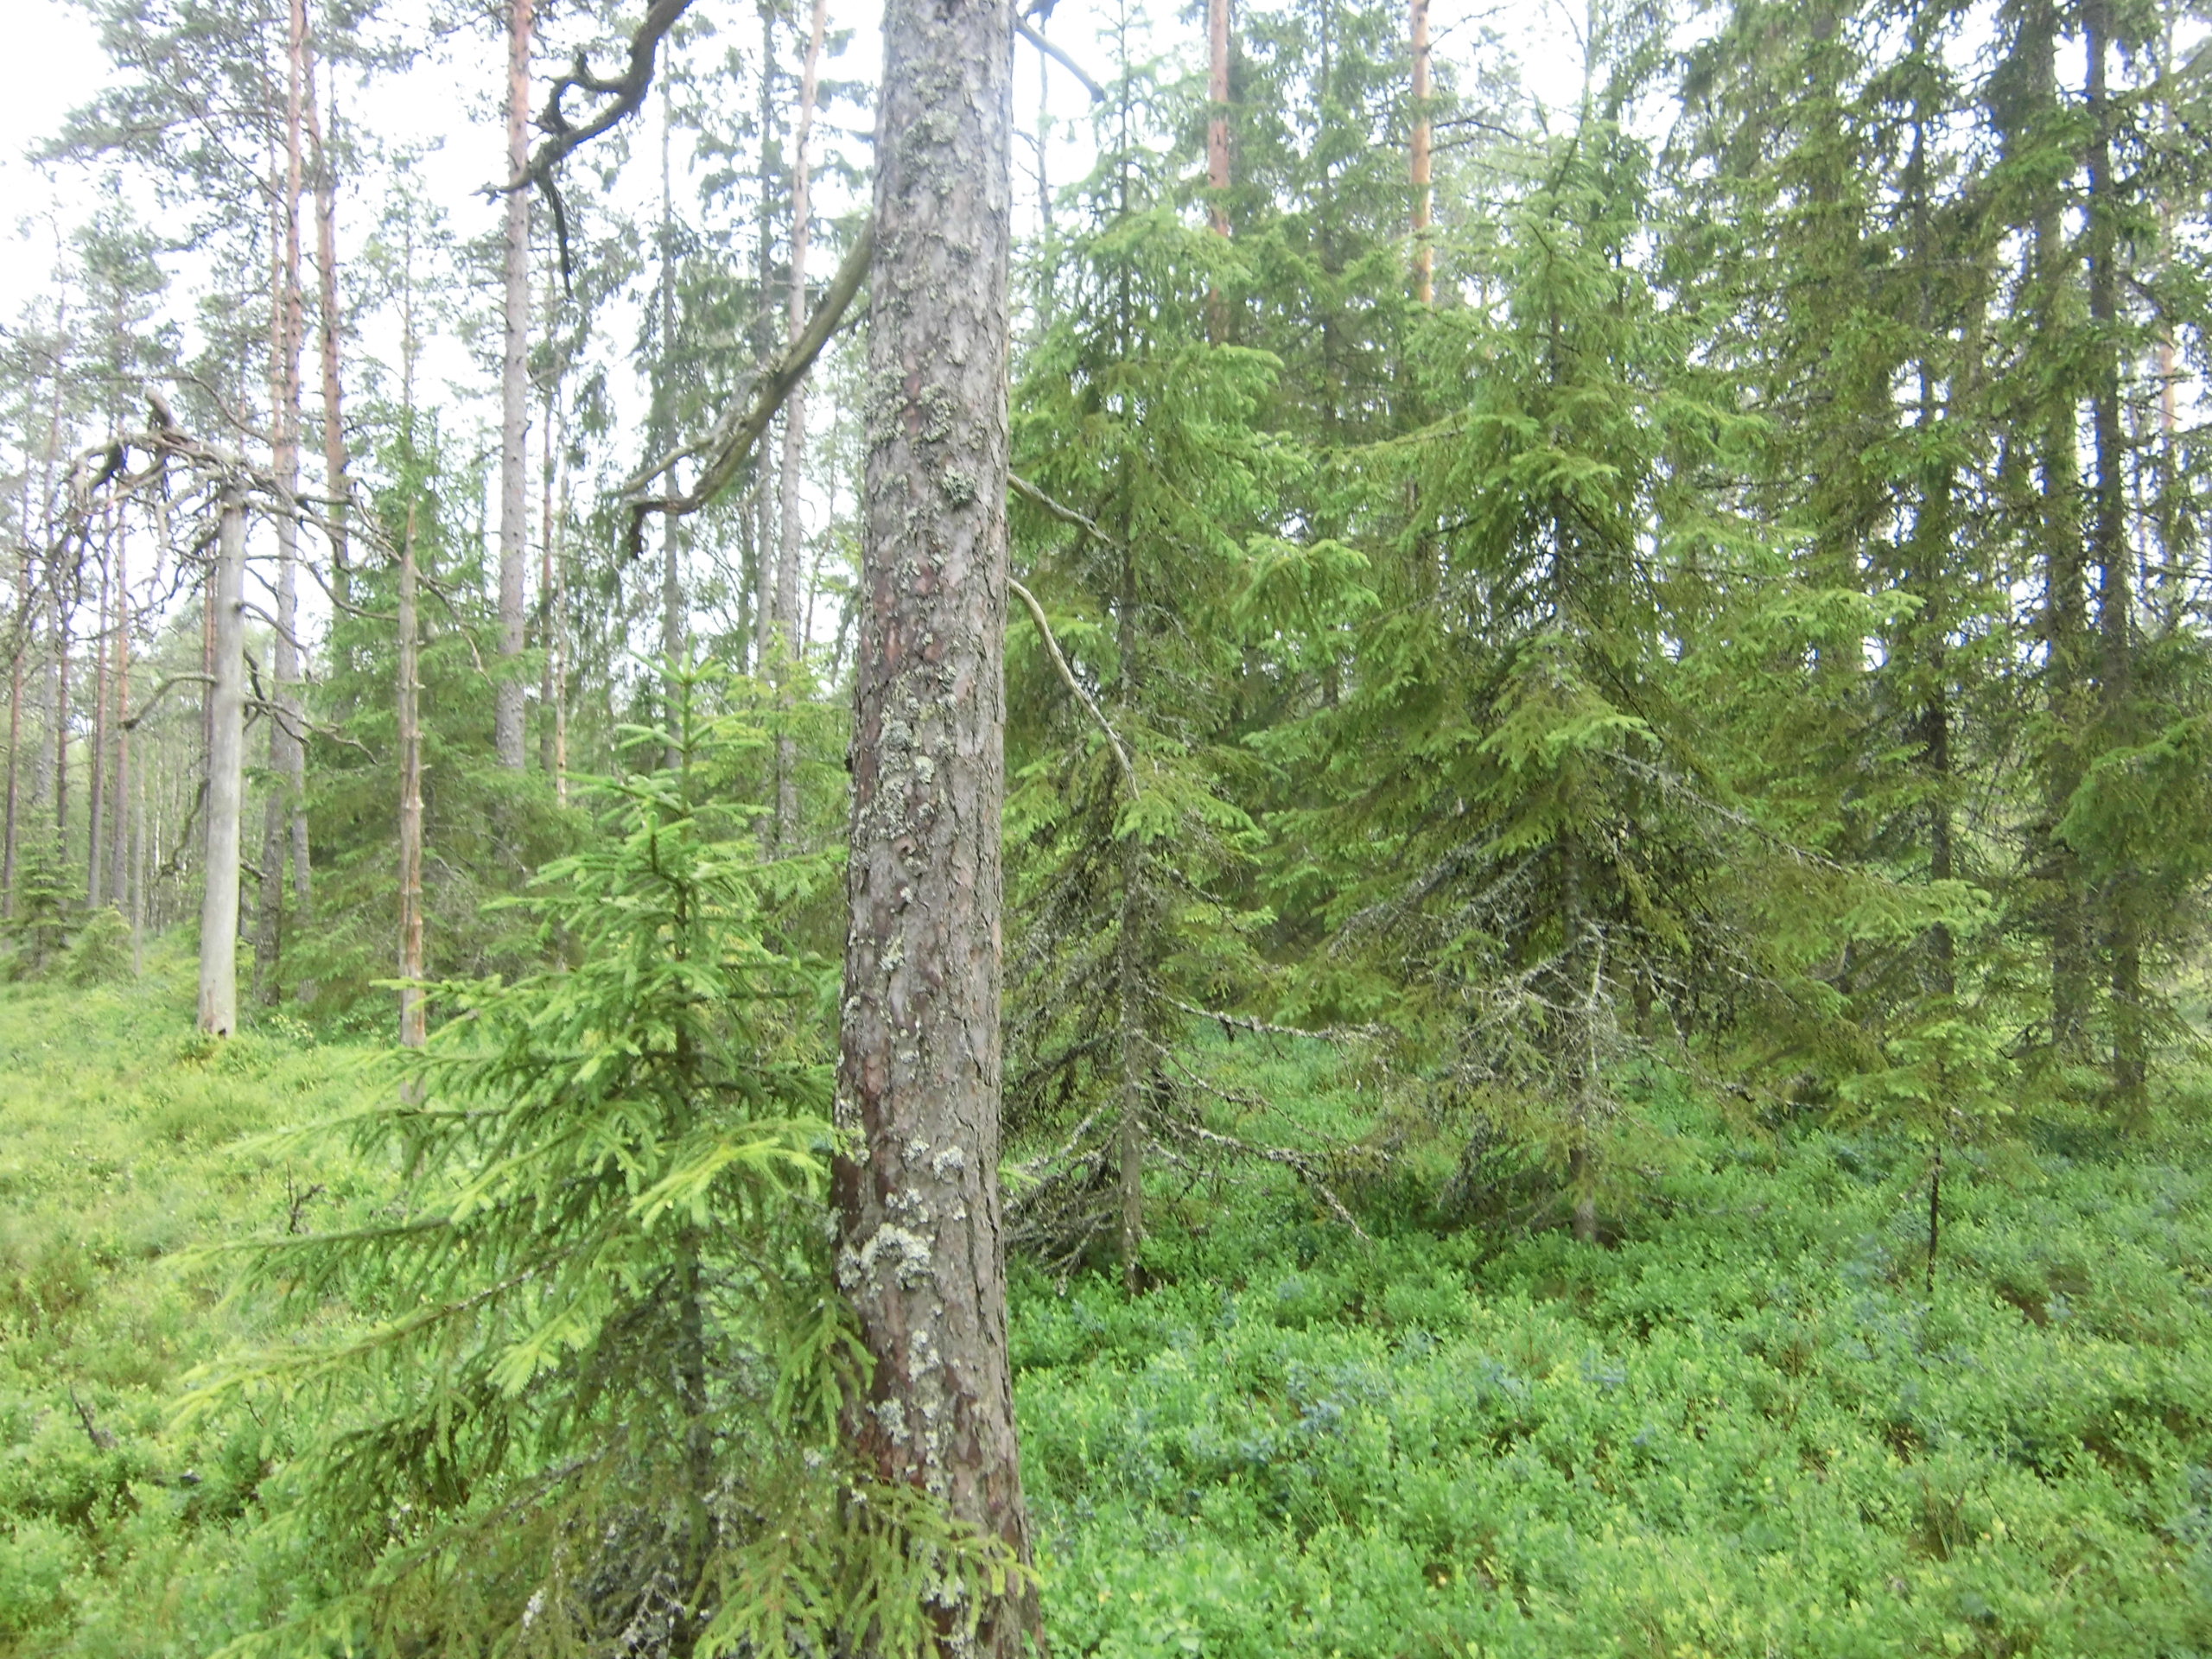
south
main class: Woodland
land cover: Pine dominated coniferous woodland
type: boreal forest
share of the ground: 50 - 75 %
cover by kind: coniferous forest trees 50 %, shrubs 25 %, herbaceous plants 15 %, lichens and mosses 10 %
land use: Forestry
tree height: > 5 m
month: July
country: SE
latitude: 57.2351
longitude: 15.2157
